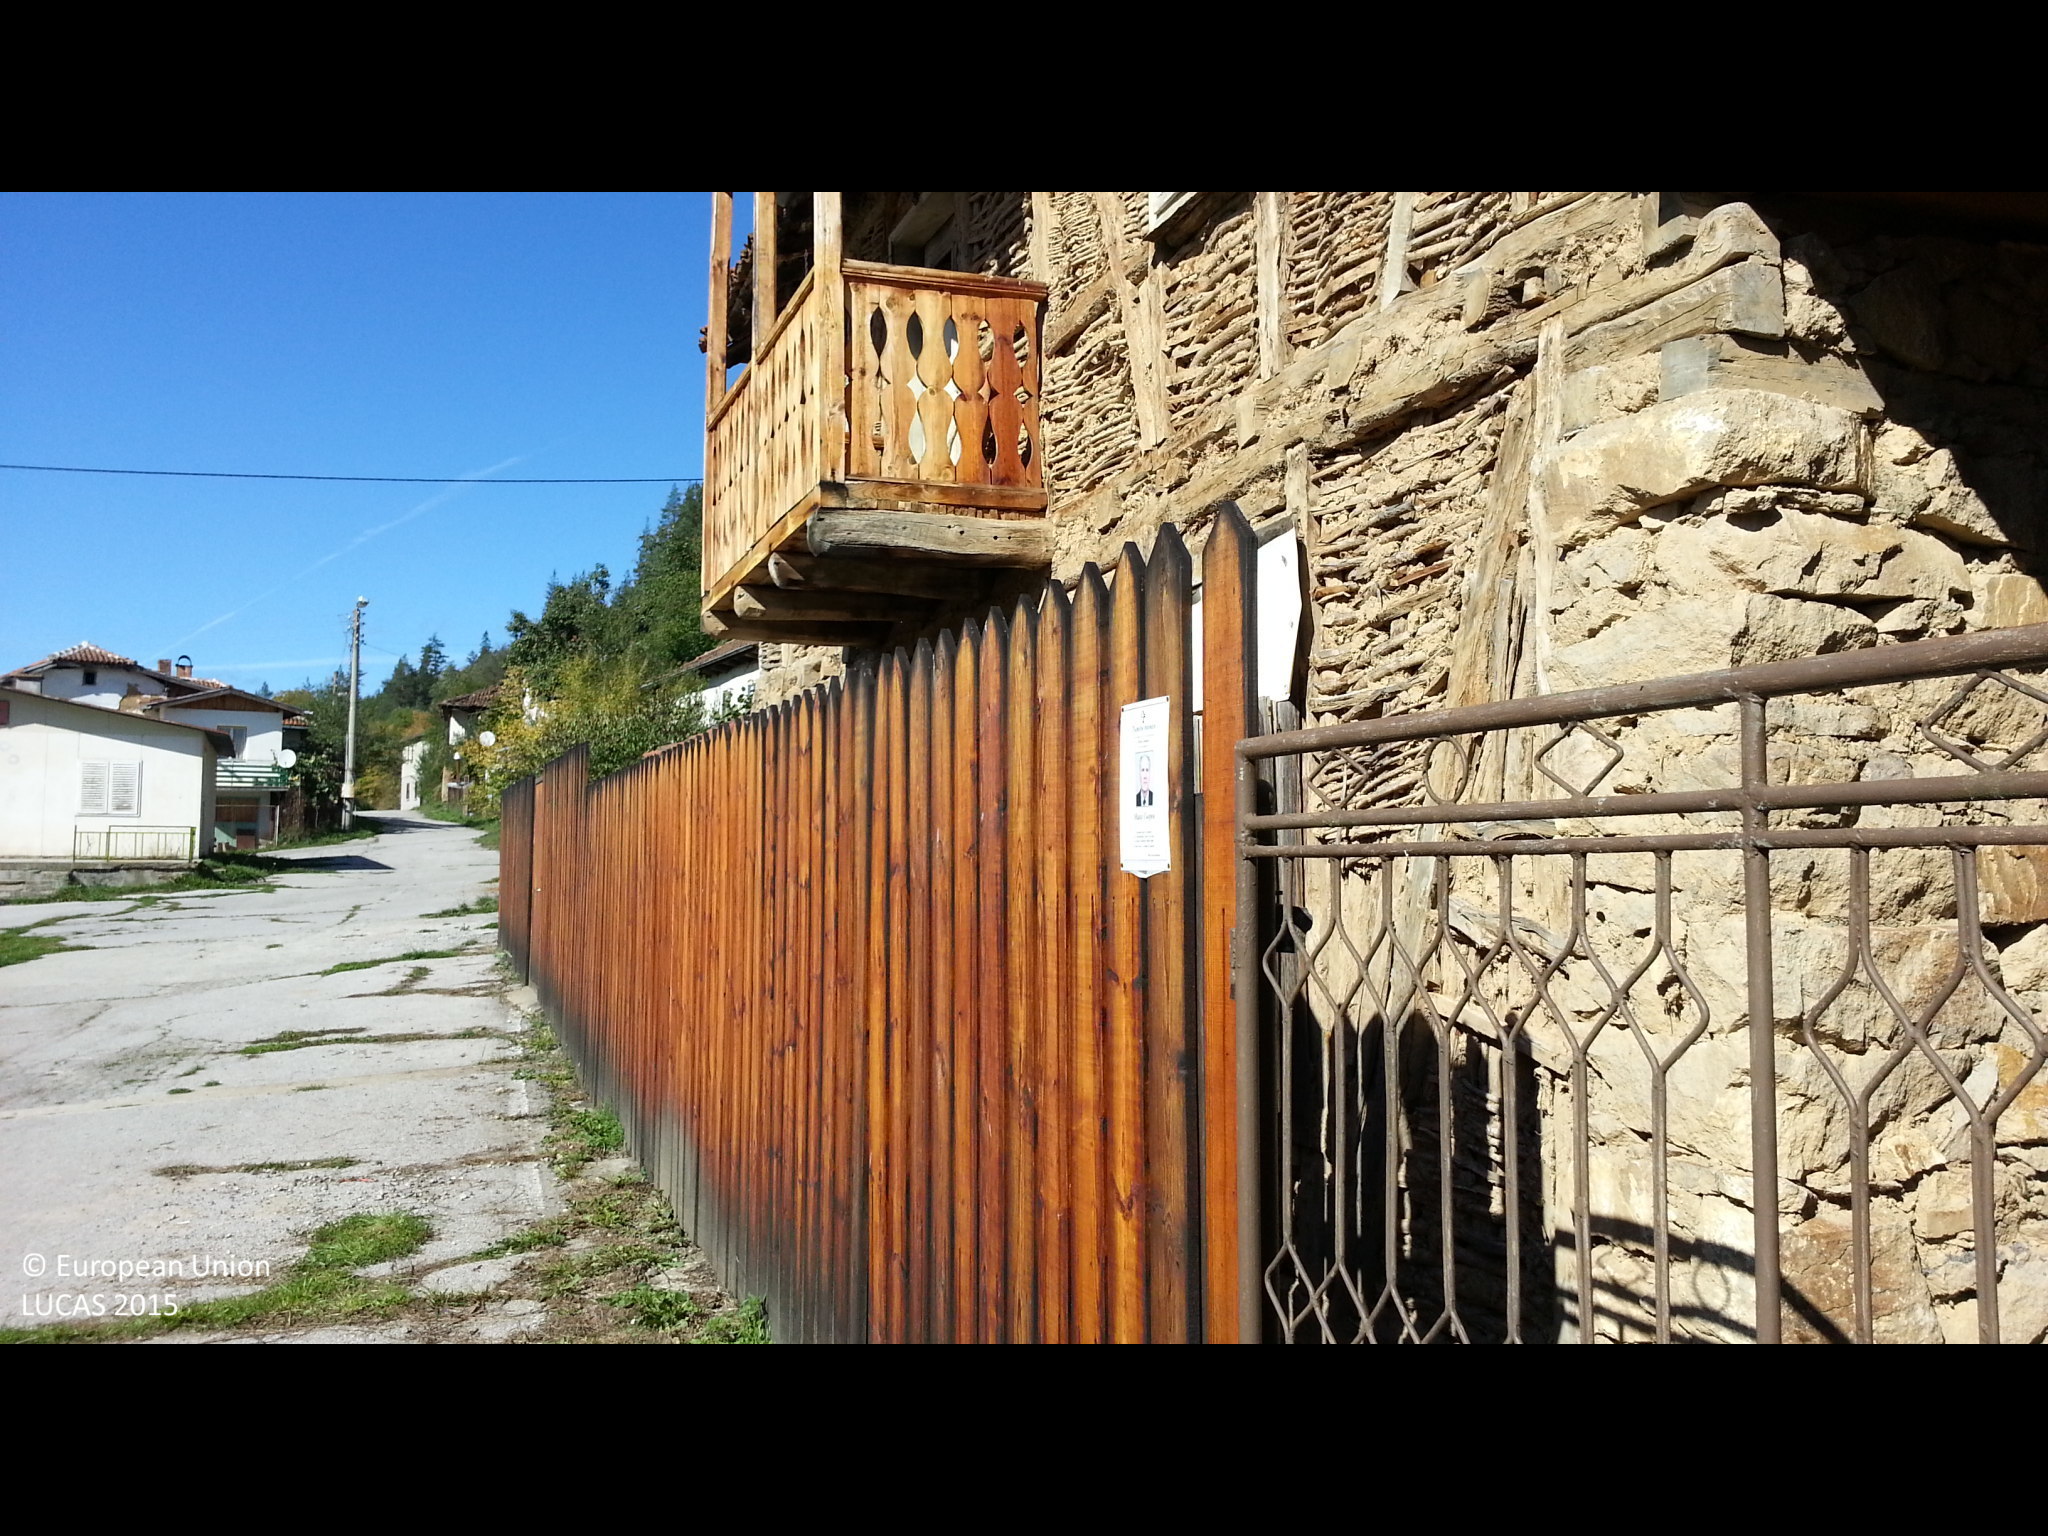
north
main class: Grassland
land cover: Grassland with sparse tree/shrub cover
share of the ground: > 75 %
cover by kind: herbaceous plants 90 %, broadleaved forest trees 5 %, shrubs 5 %
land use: Residential
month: October
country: BG
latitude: 42.6487
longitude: 22.5997
